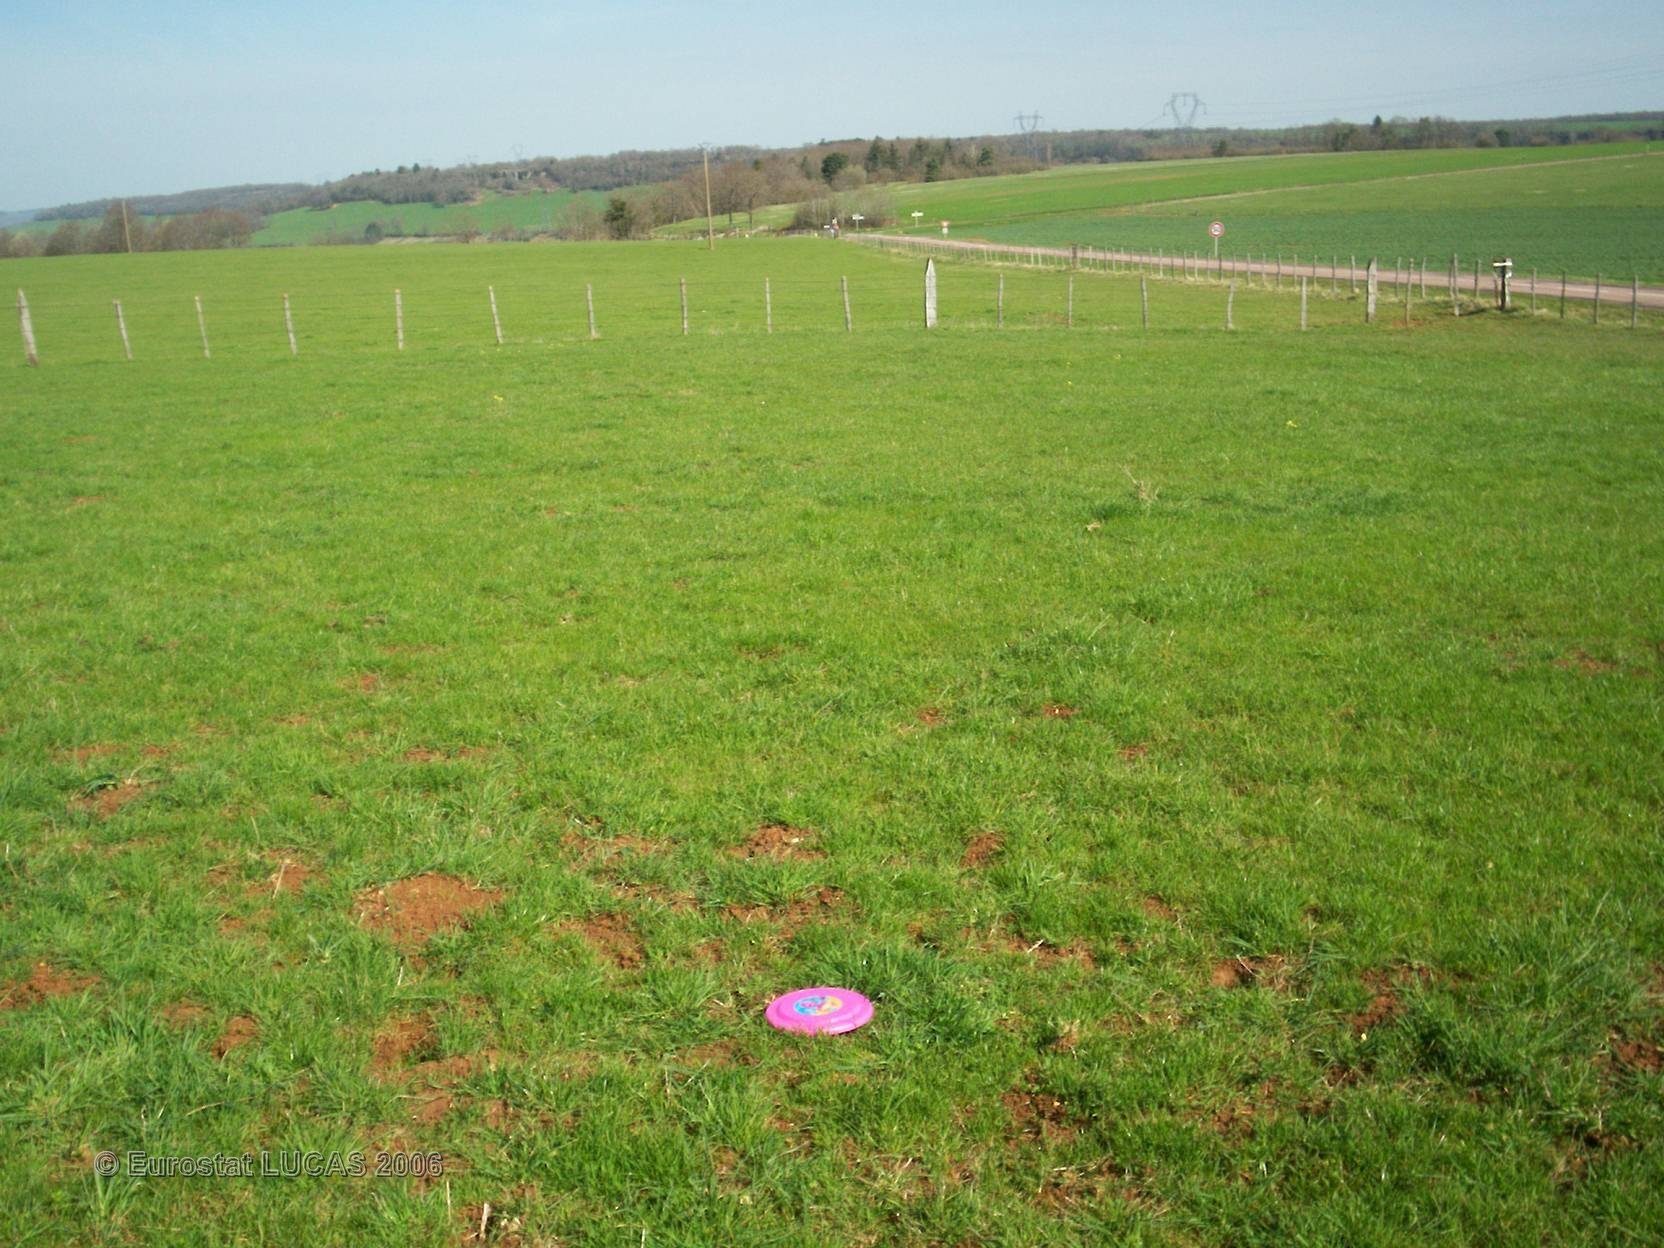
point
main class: Grassland
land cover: Grassland without tree/shrub cover
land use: Agriculture (excluding fallow land and kitchen gardens)
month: April
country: FR
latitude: 47.3869
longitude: 4.5815
